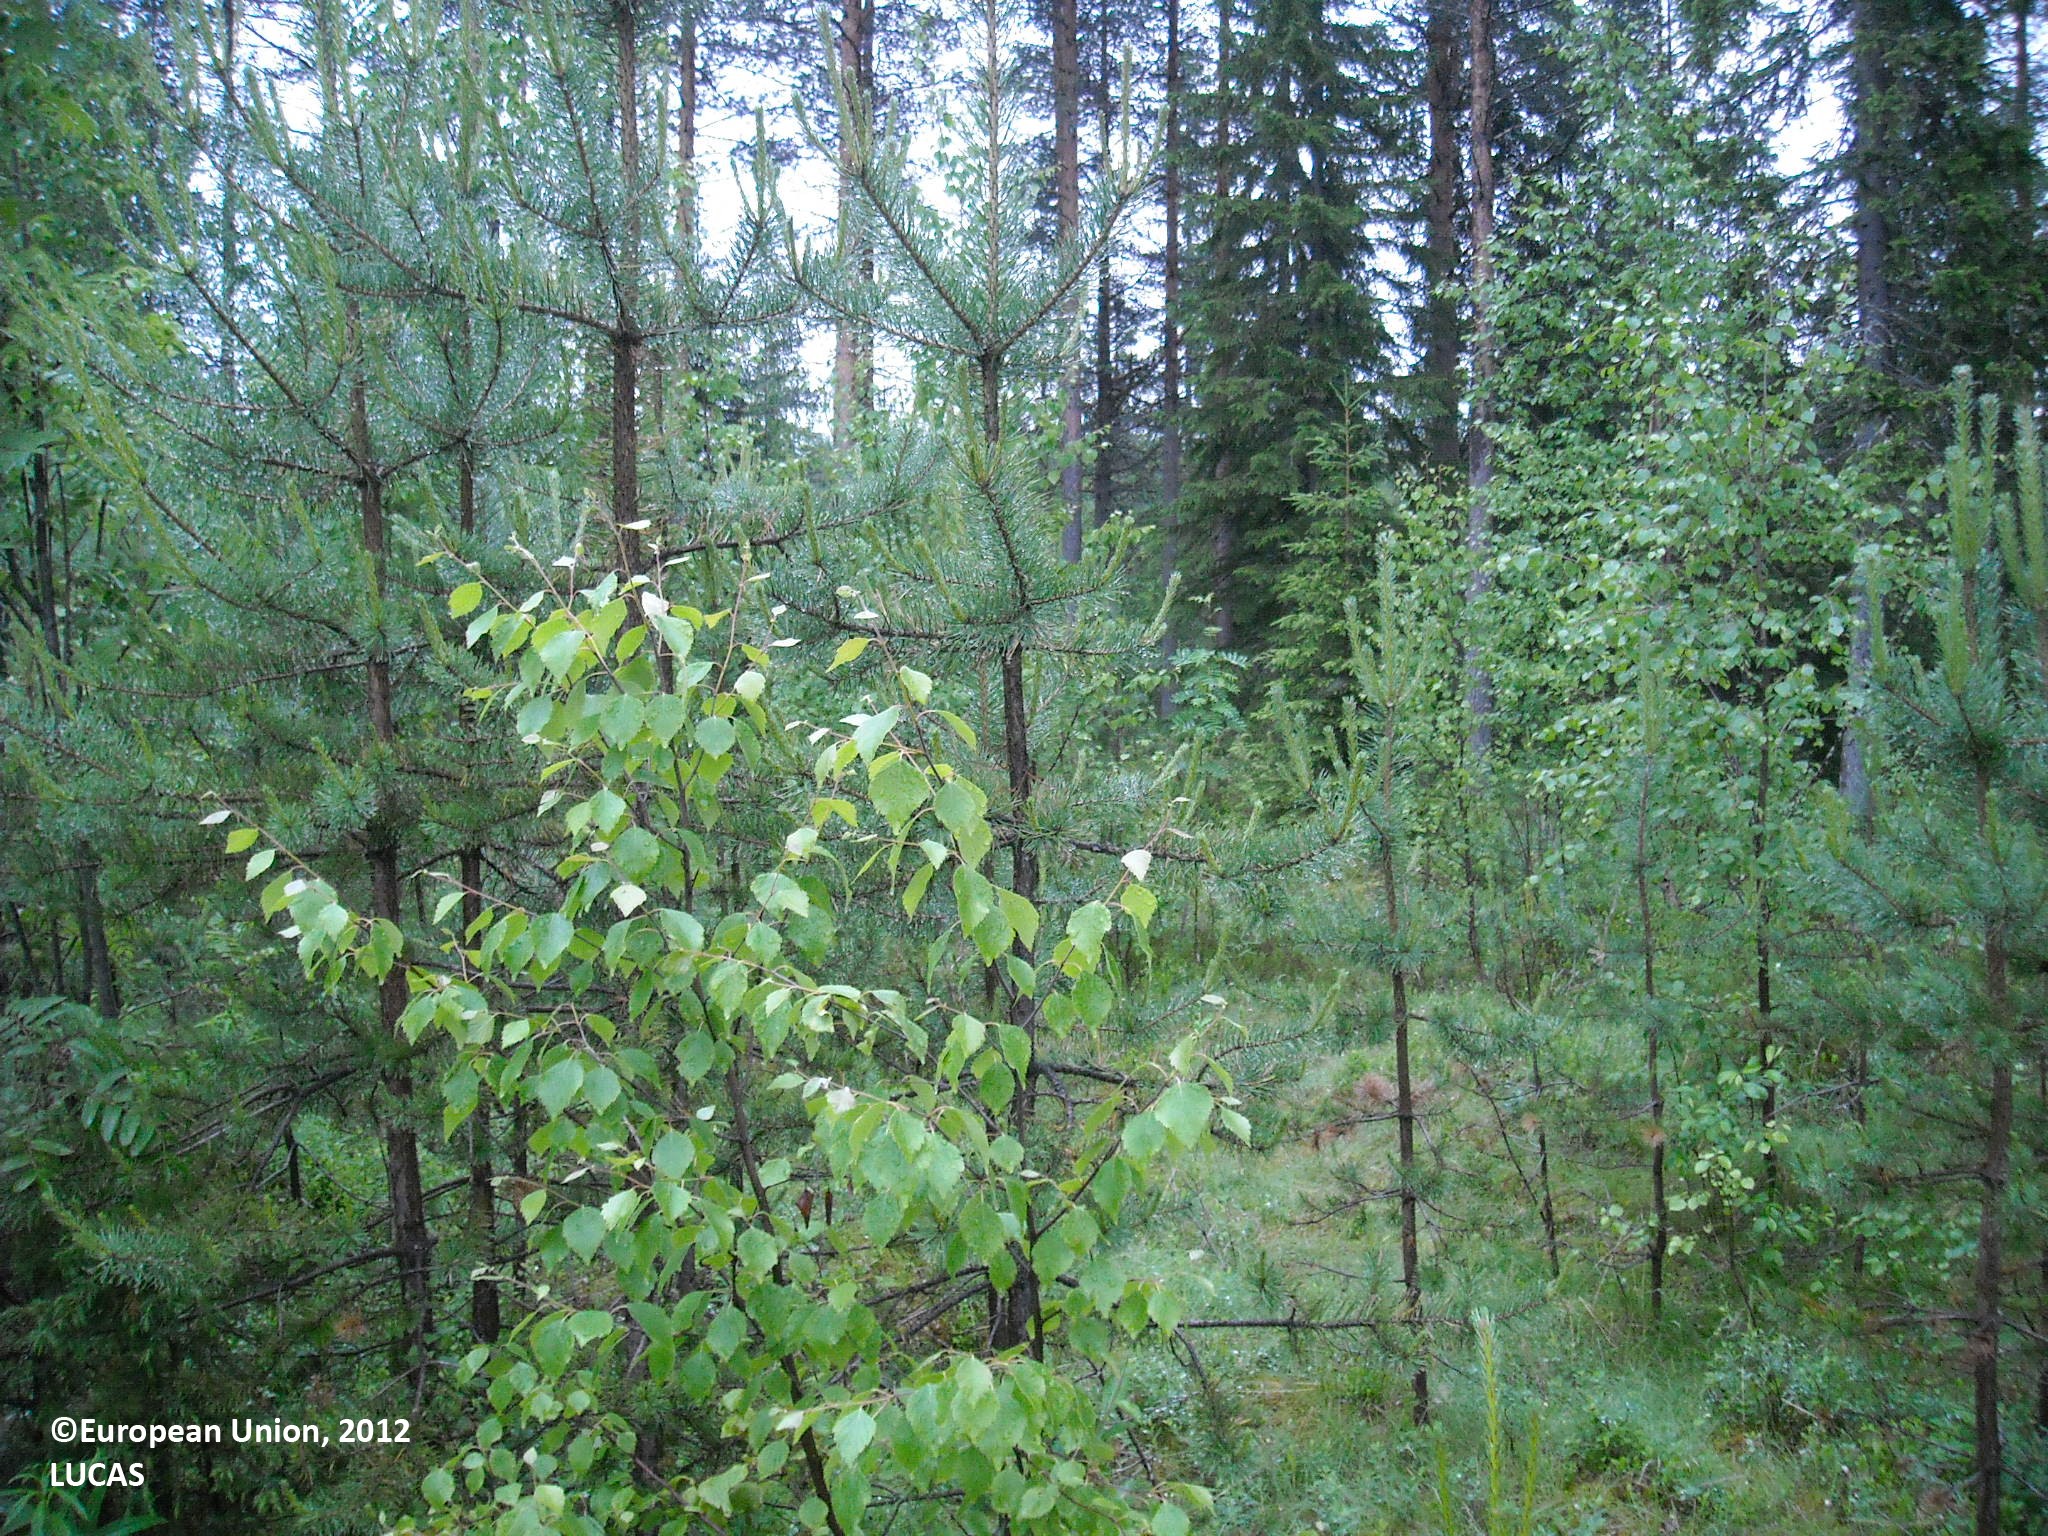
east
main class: Woodland
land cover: Pine dominated mixed woodland
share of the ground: > 75 %
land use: Forestry
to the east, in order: Pine dominated mixed woodland; Other mixed woodland; Shrubland without tree cover; Electric lines; Shrubland without tree cover; Other mixed woodland; Peatbogs; Inland water bodies; Peatbogs; Pine dominated mixed woodland; Other mixed woodland; Other coniferous woodland; Shrubland without tree cover; Electric lines; Shrubland without tree cover; Other coniferous woodland; Other mixed woodland
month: July
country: FI
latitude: 64.5900
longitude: 27.6285
